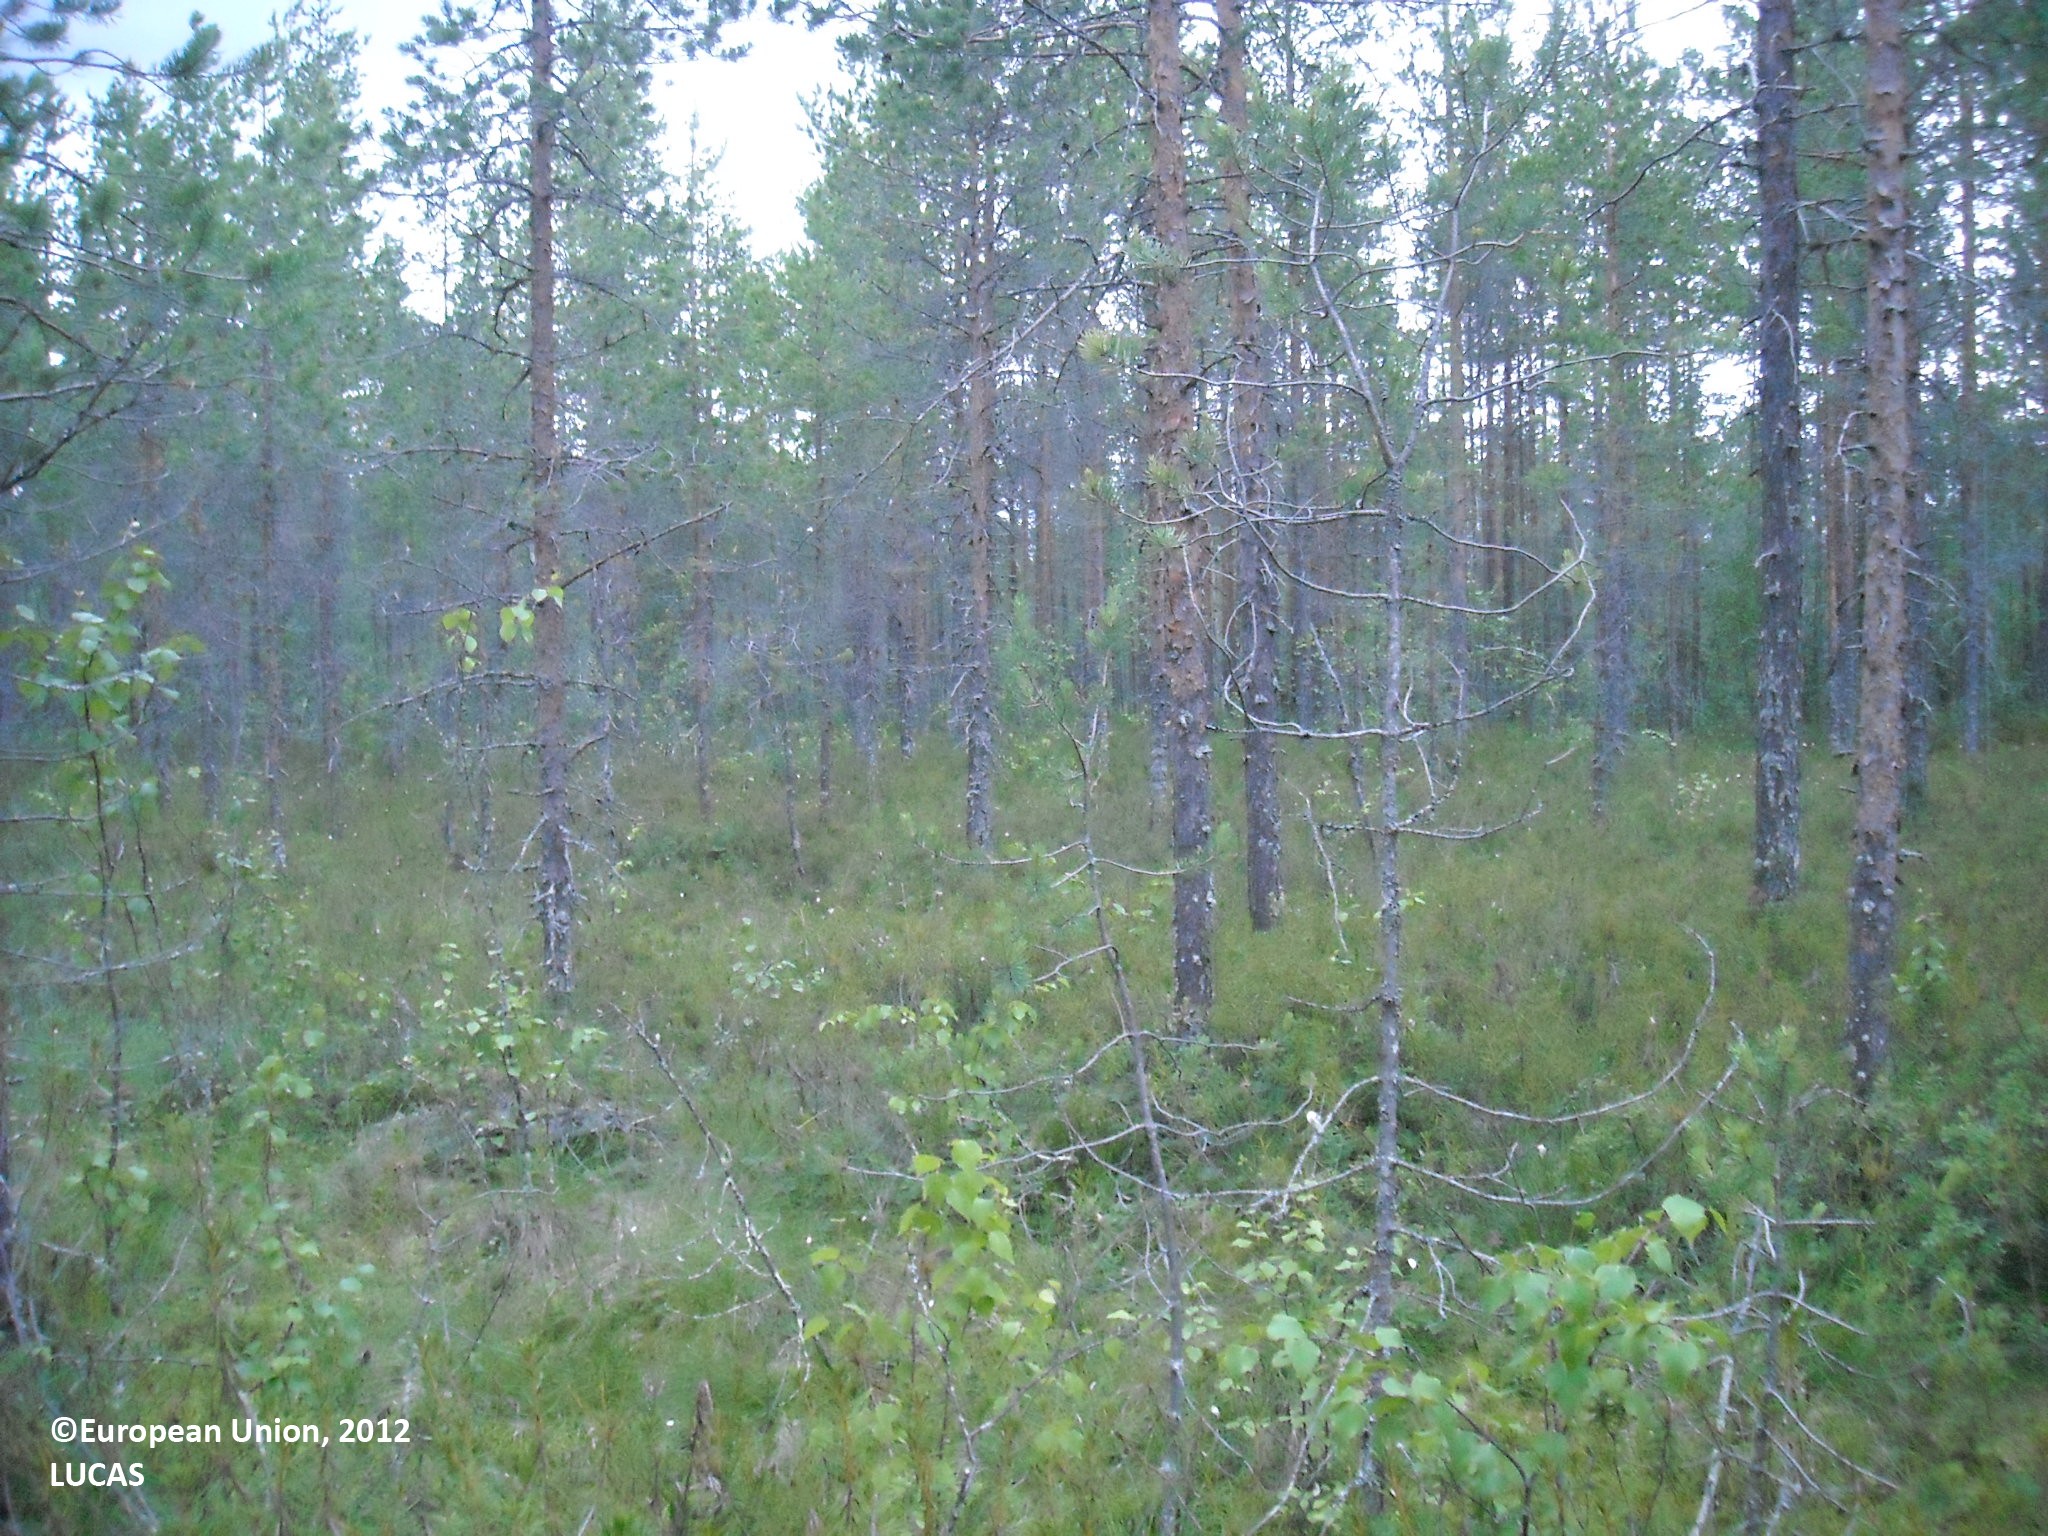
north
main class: Woodland
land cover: Pine dominated coniferous woodland
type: mire and swamp forests
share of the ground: 50 - 75 %
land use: Forestry
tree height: > 5 m
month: July
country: FI
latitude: 65.0354
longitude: 26.7845
